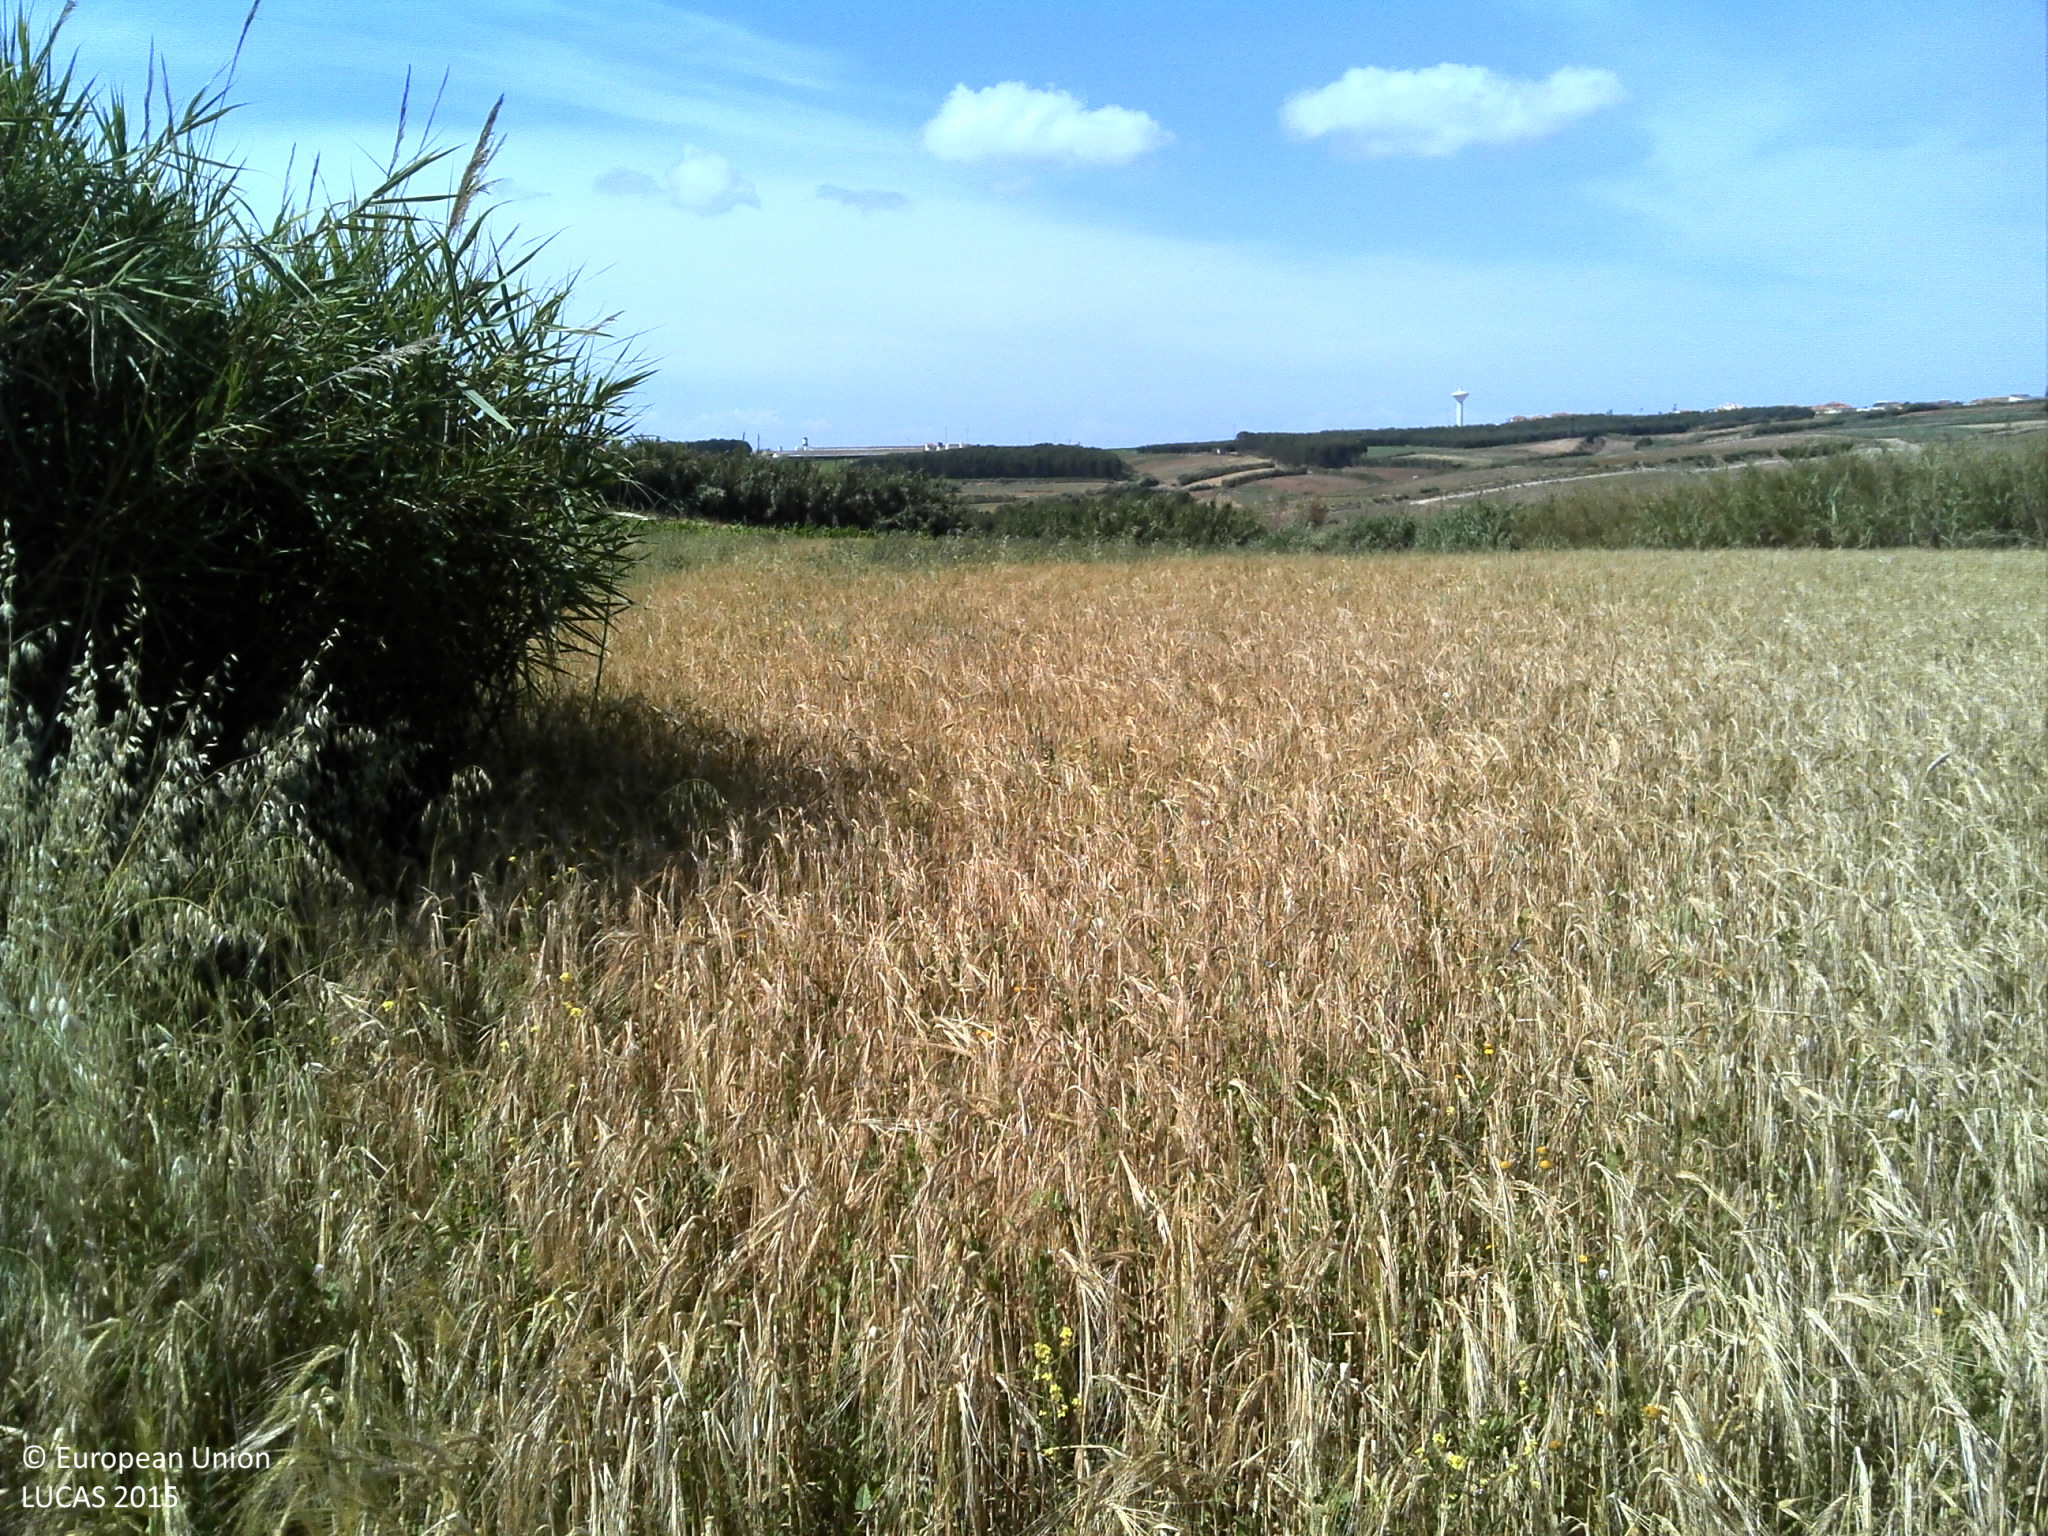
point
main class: Cropland
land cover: Common wheat
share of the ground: > 75 %
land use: Agriculture (excluding fallow land and kitchen gardens)
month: June
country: PT
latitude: 39.2889
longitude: -9.3267
